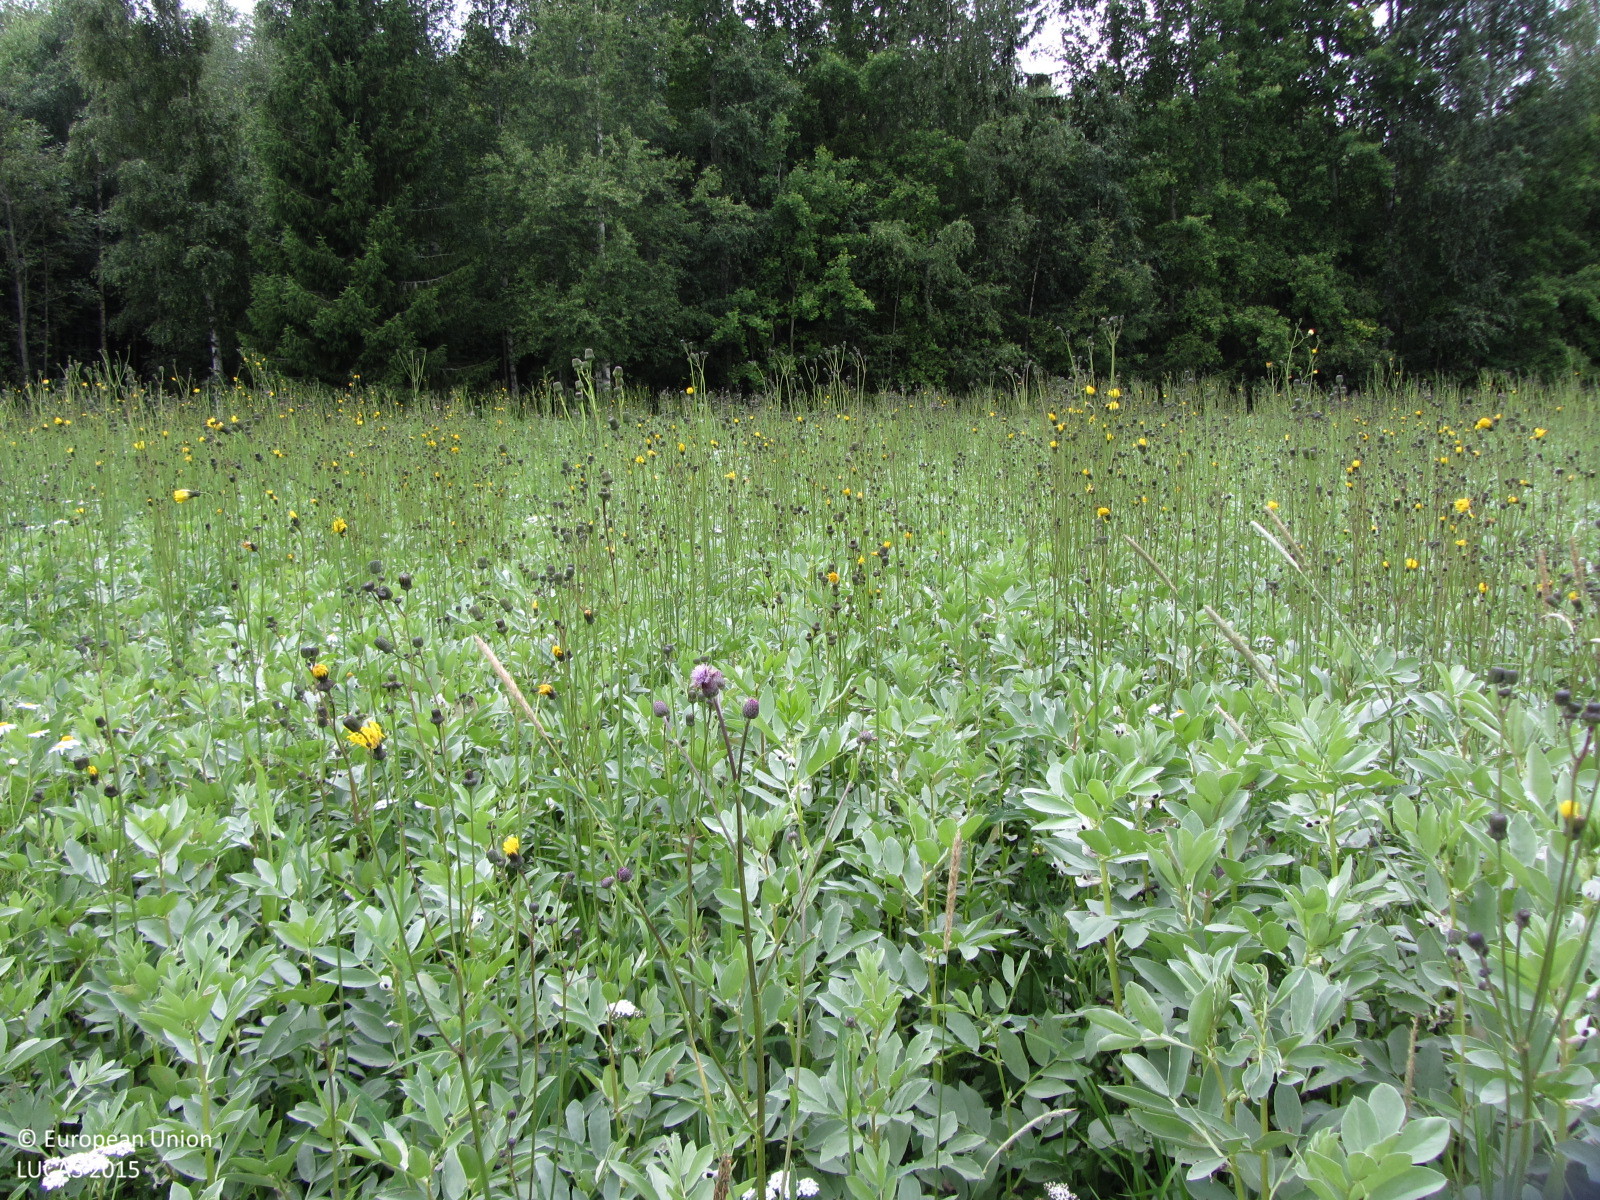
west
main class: Cropland
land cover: Dry pulses
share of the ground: > 75 %
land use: Agriculture (excluding fallow land and kitchen gardens)
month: July
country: FI
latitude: 60.4838
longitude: 24.2025
